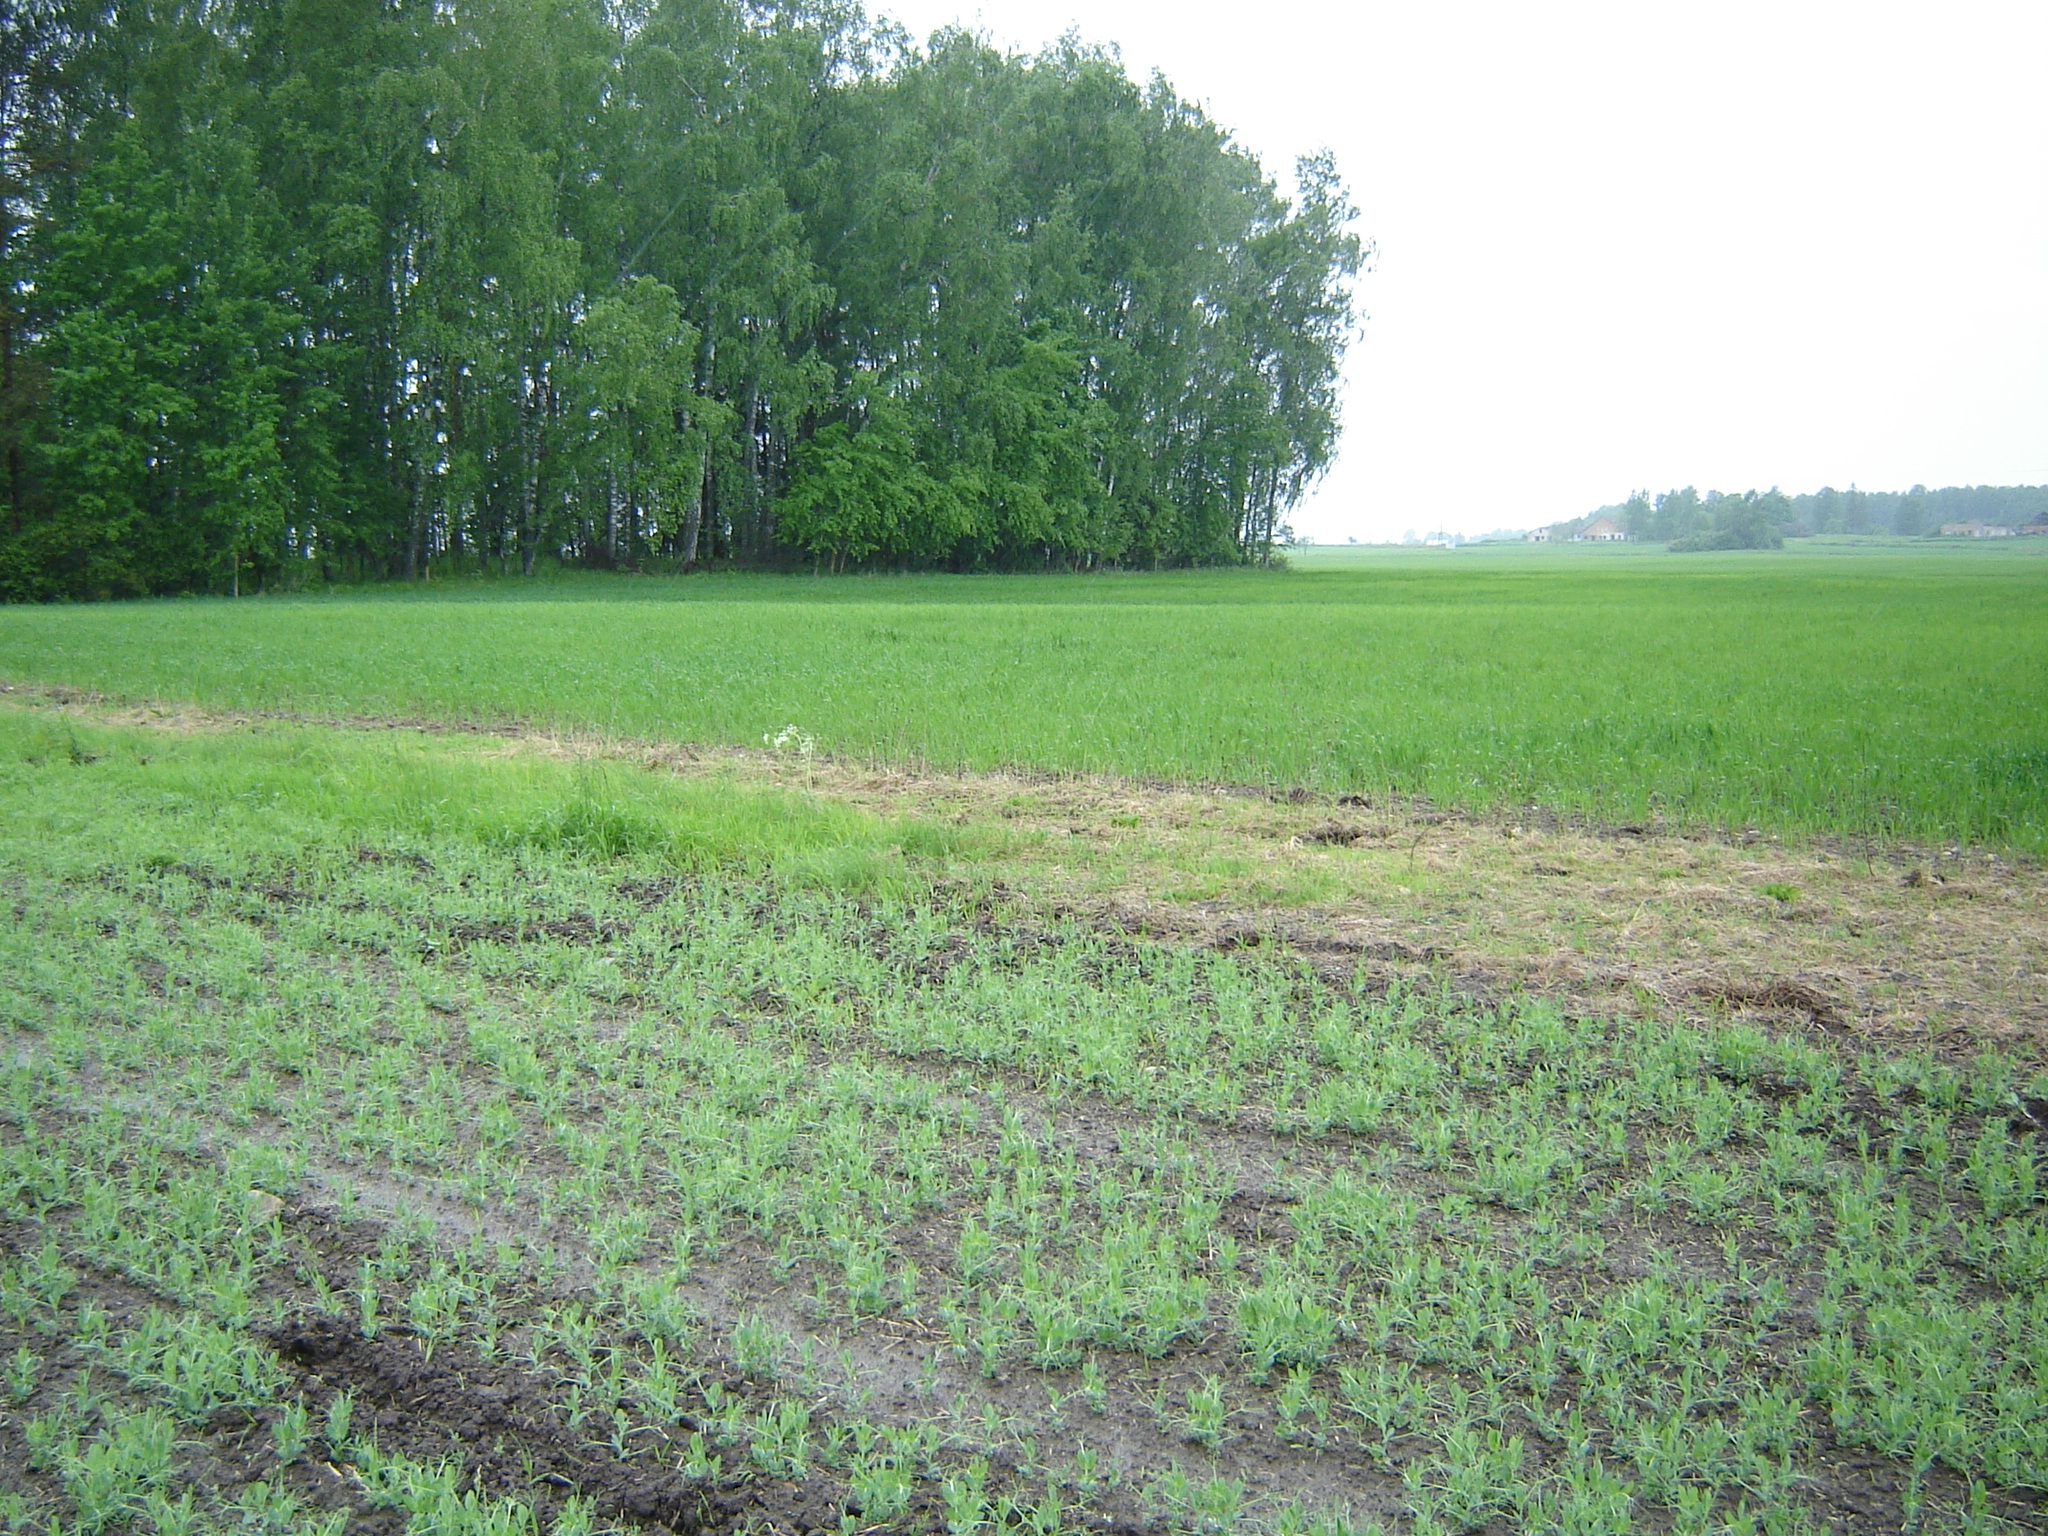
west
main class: Cropland
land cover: Dry pulses
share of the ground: > 75 %
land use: Agriculture (excluding fallow land and kitchen gardens)
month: May
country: LT
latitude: 55.9996
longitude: 25.2692
